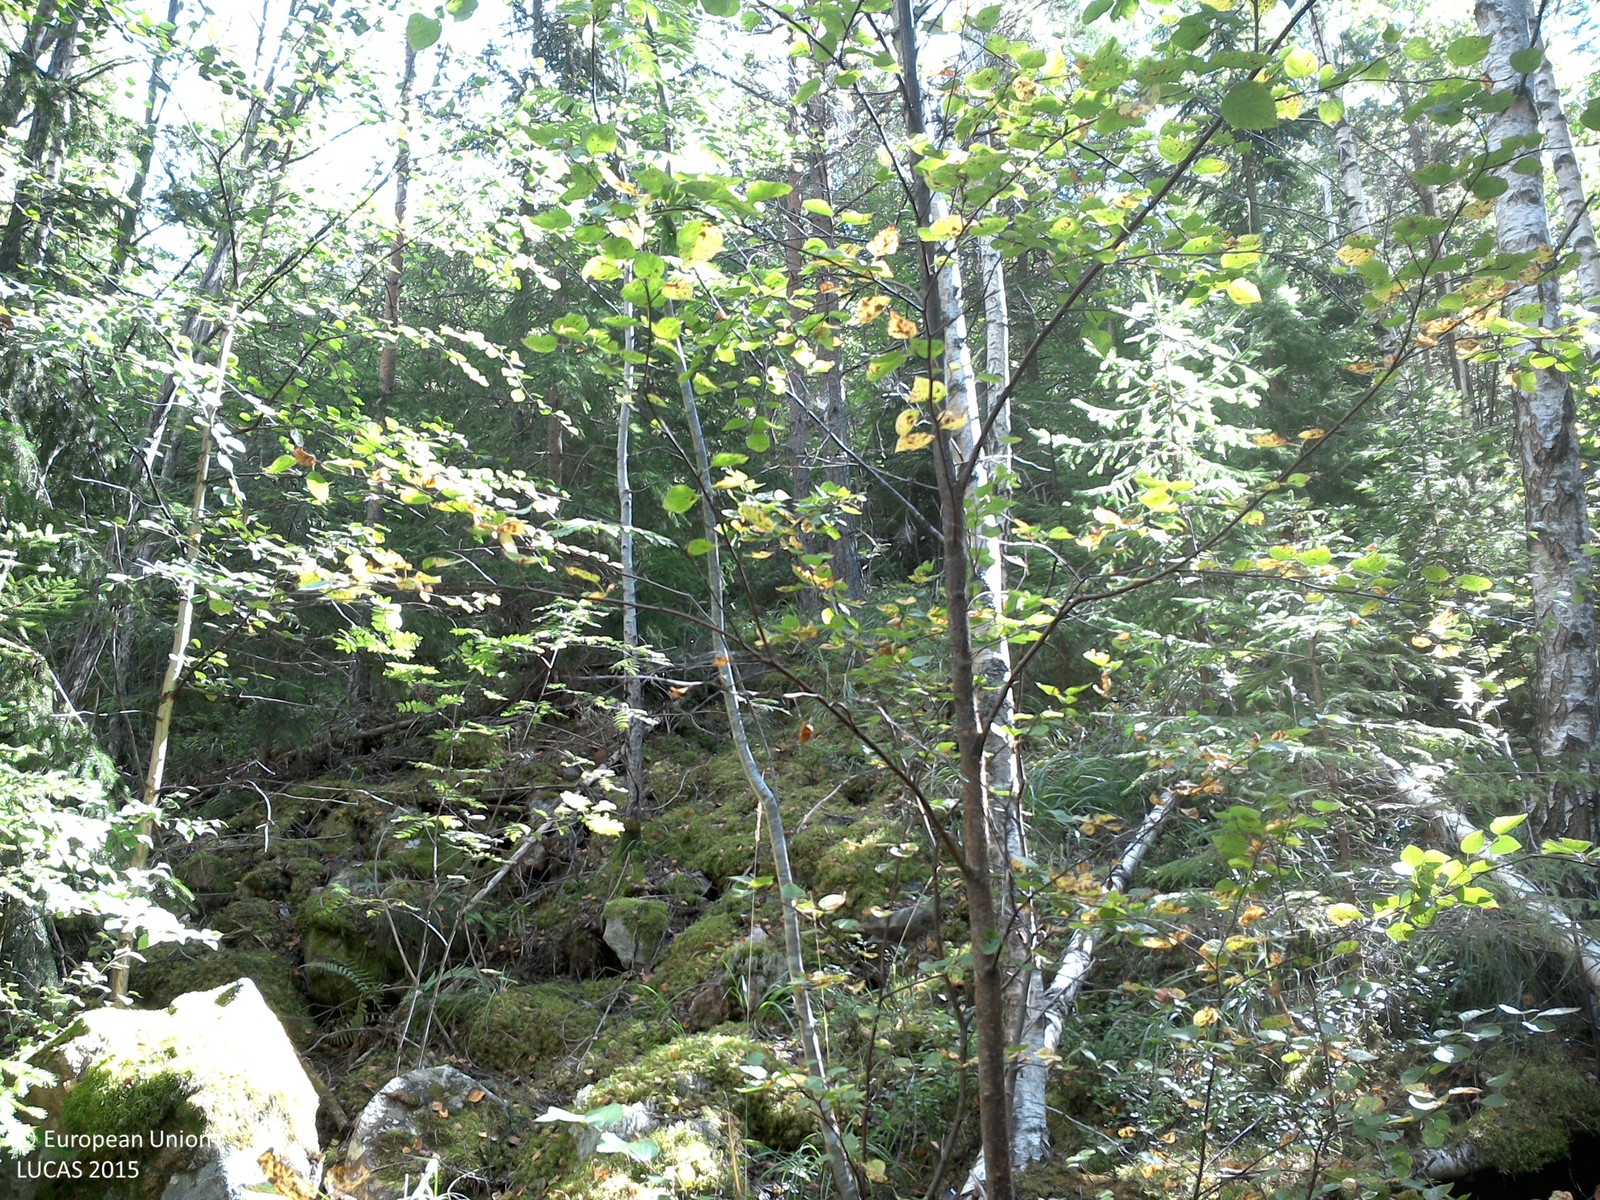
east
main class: Woodland
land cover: Spruce dominated mixed woodland
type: boreal forest
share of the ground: > 75 %
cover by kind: coniferous forest trees 45 %, herbaceous plants 25 %, broadleaved forest trees 20 %, shrubs 5 %, lichens and mosses 5 %
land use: Forestry
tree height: > 5 m
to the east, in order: Spruce dominated mixed woodland; Spruce dominated coniferous woodland; Spruce dominated mixed woodland; Spruce dominated coniferous woodland
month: August
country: SE
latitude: 58.0789
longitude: 15.3025
